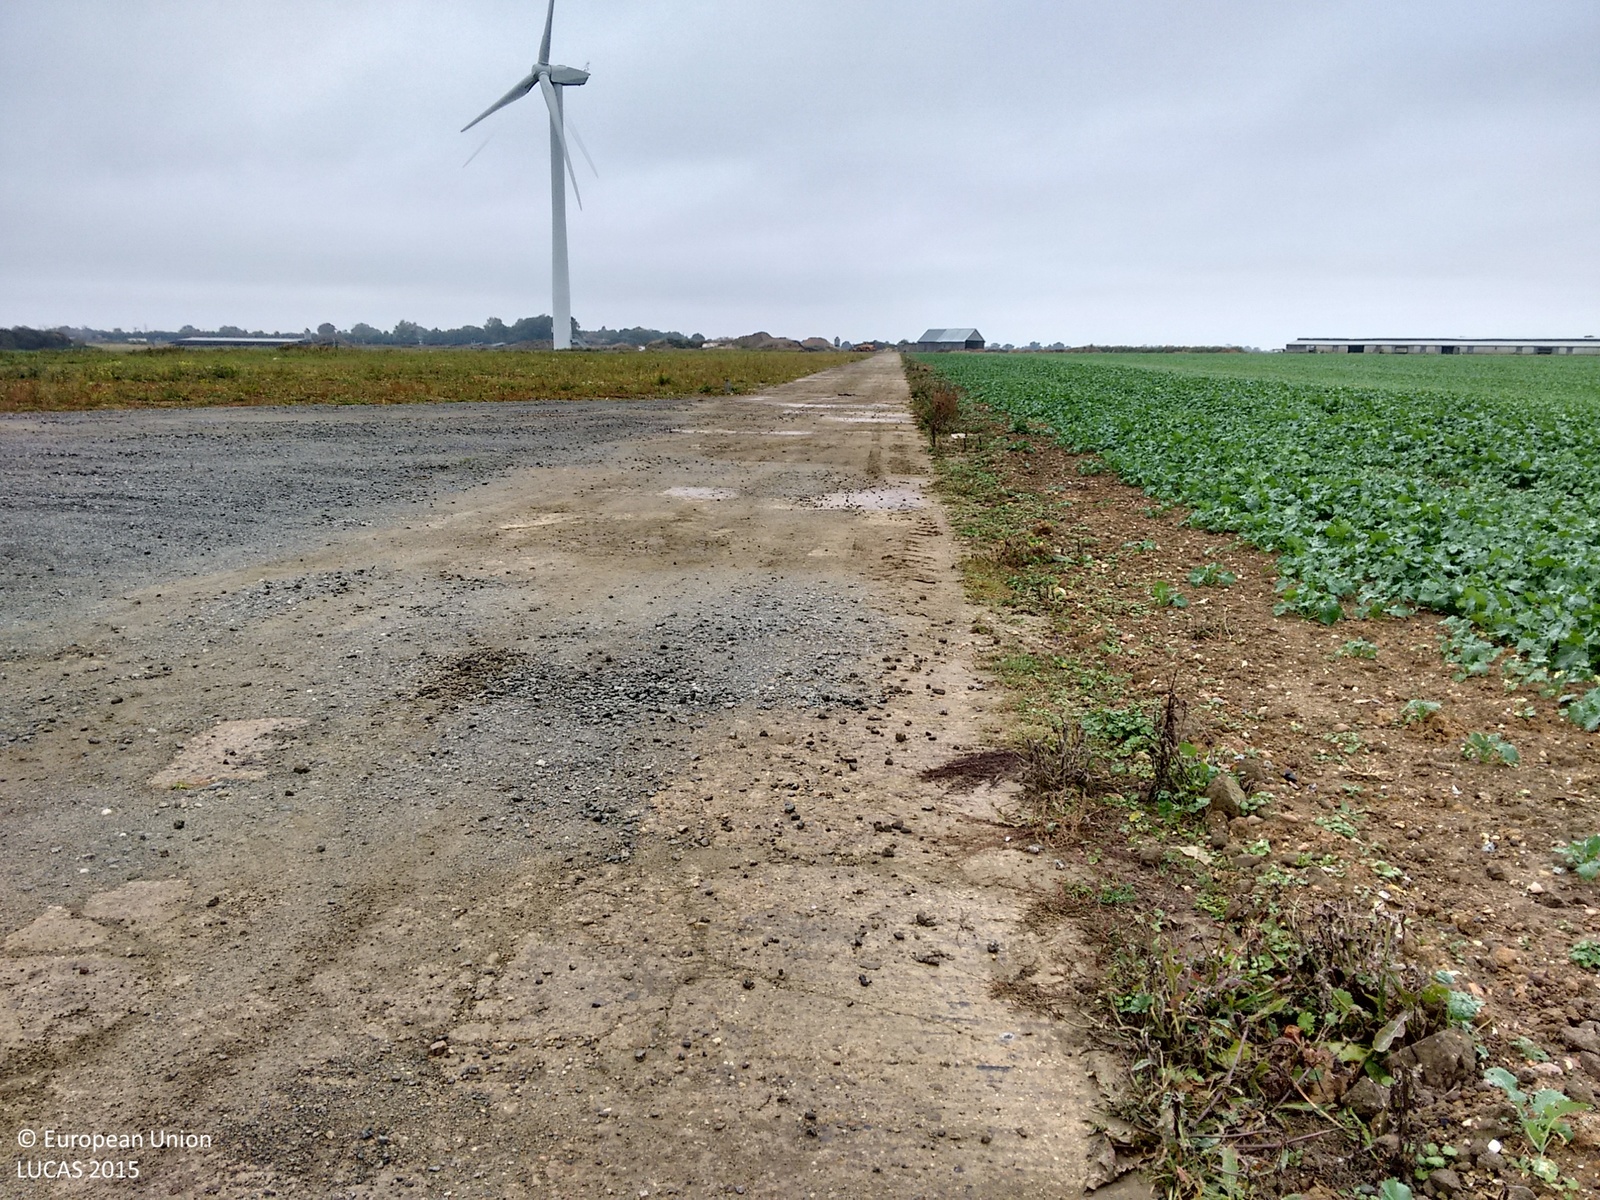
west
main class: Cropland
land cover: Rape and turnip rape
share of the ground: > 75 %
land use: Agriculture (excluding fallow land and kitchen gardens)
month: October
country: GB
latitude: 52.3642
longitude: 1.5370
